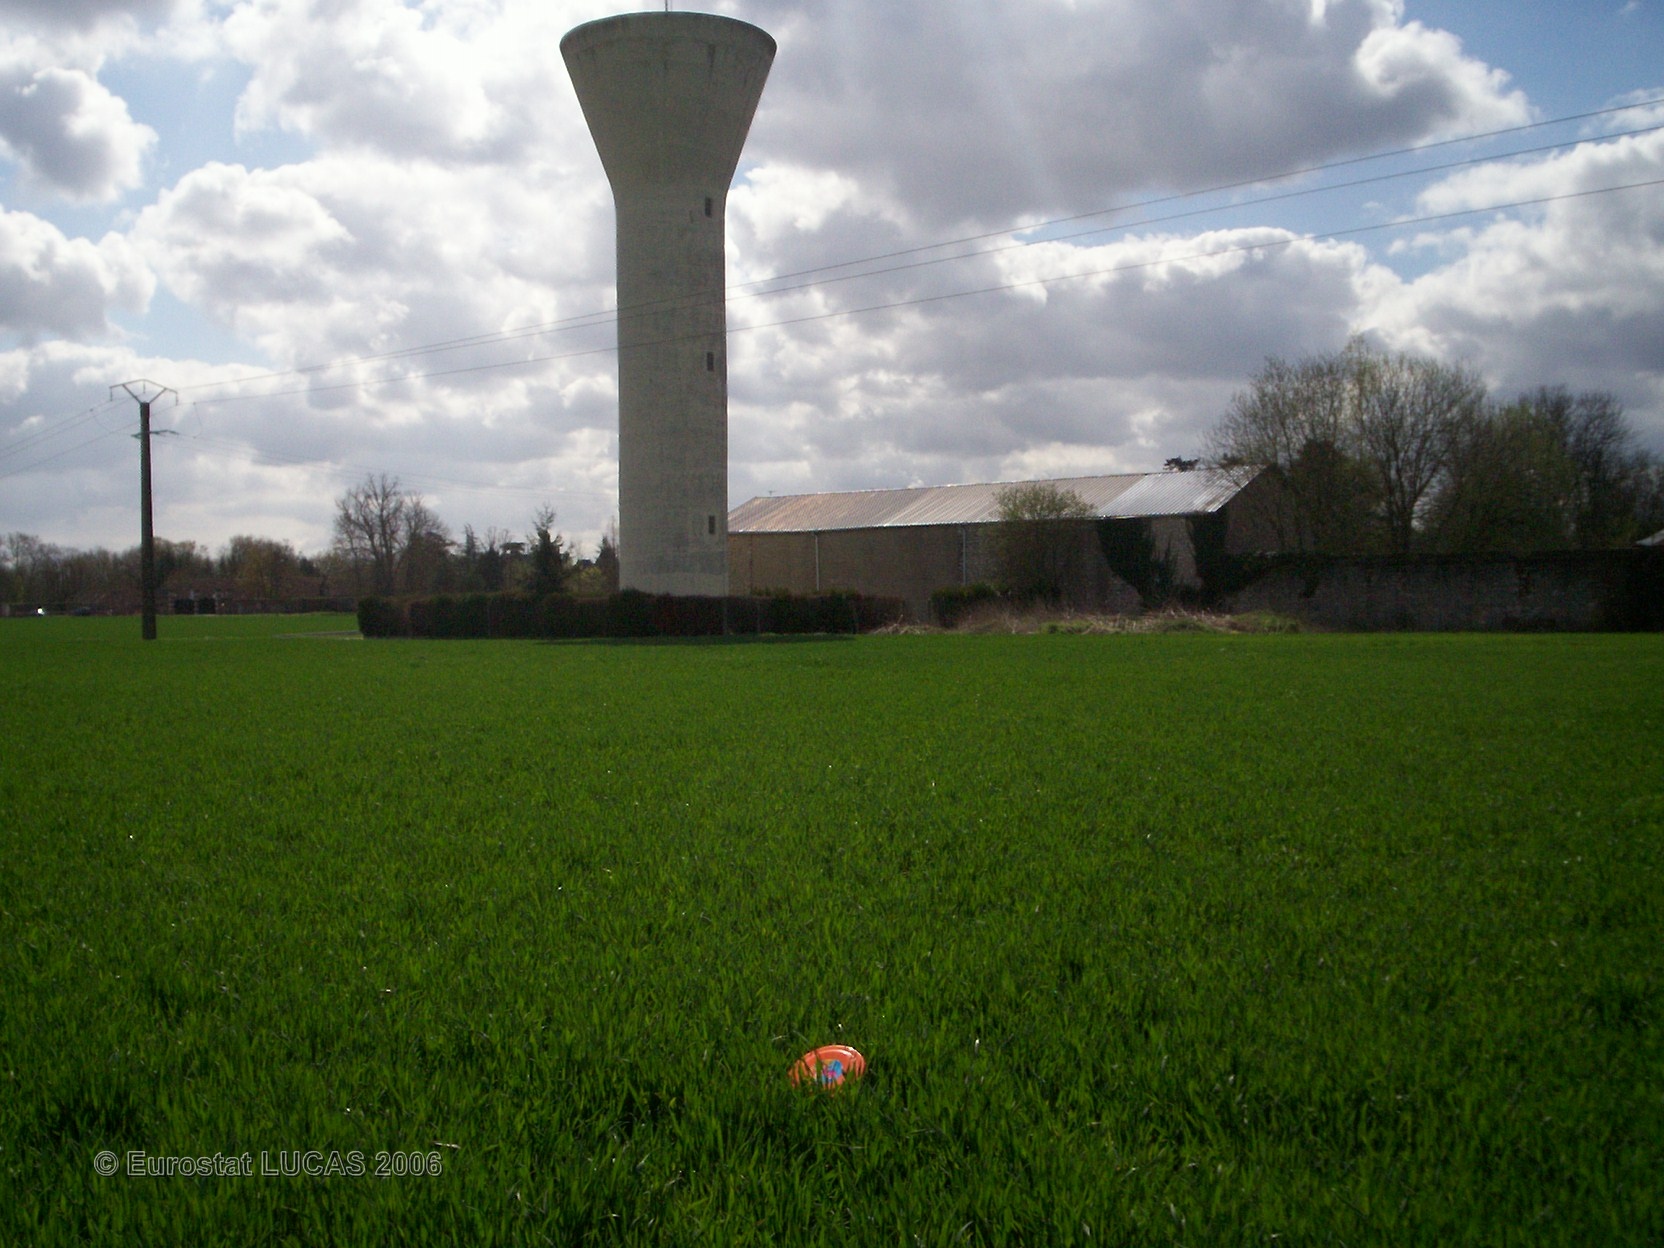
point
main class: Cropland
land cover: Common wheat
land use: Agriculture (excluding fallow land and kitchen gardens)
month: April
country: FR
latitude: 48.4906
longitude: 2.7515
